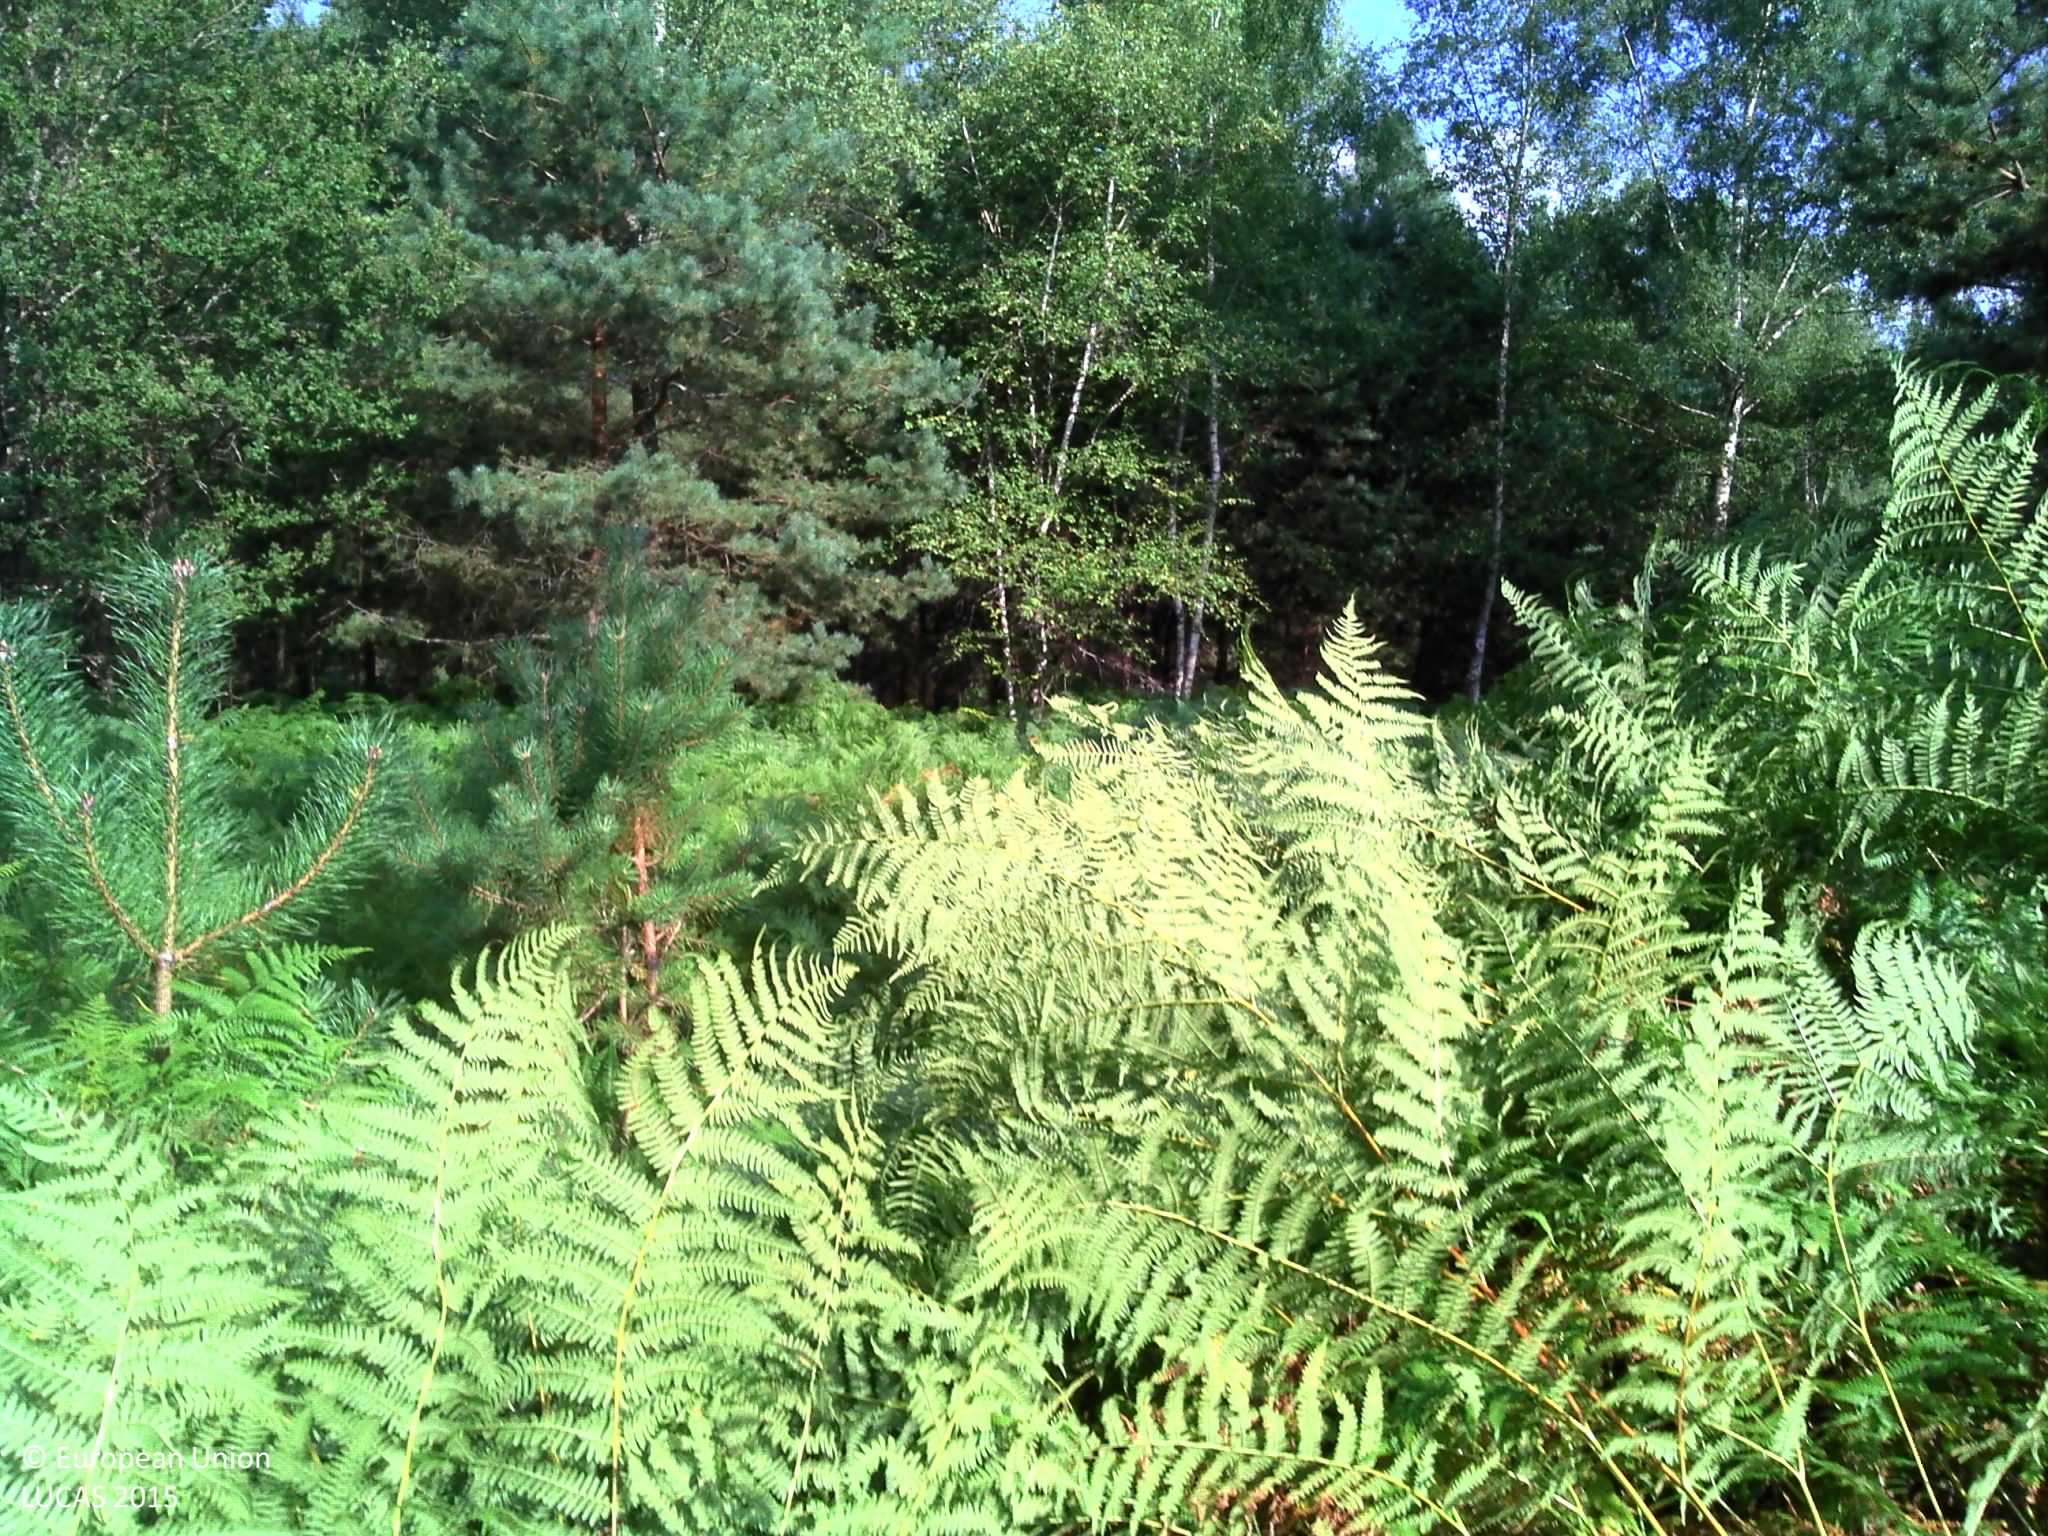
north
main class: Woodland
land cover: Broadleaved woodland
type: acidophilous oak and oak-birch forest
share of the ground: 25 - 50 %
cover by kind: herbaceous plants 60 %, broadleaved forest trees 40 %
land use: Forestry
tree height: > 5 m
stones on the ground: < 10 %
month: August
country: FR
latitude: 47.3639
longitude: 2.1385
